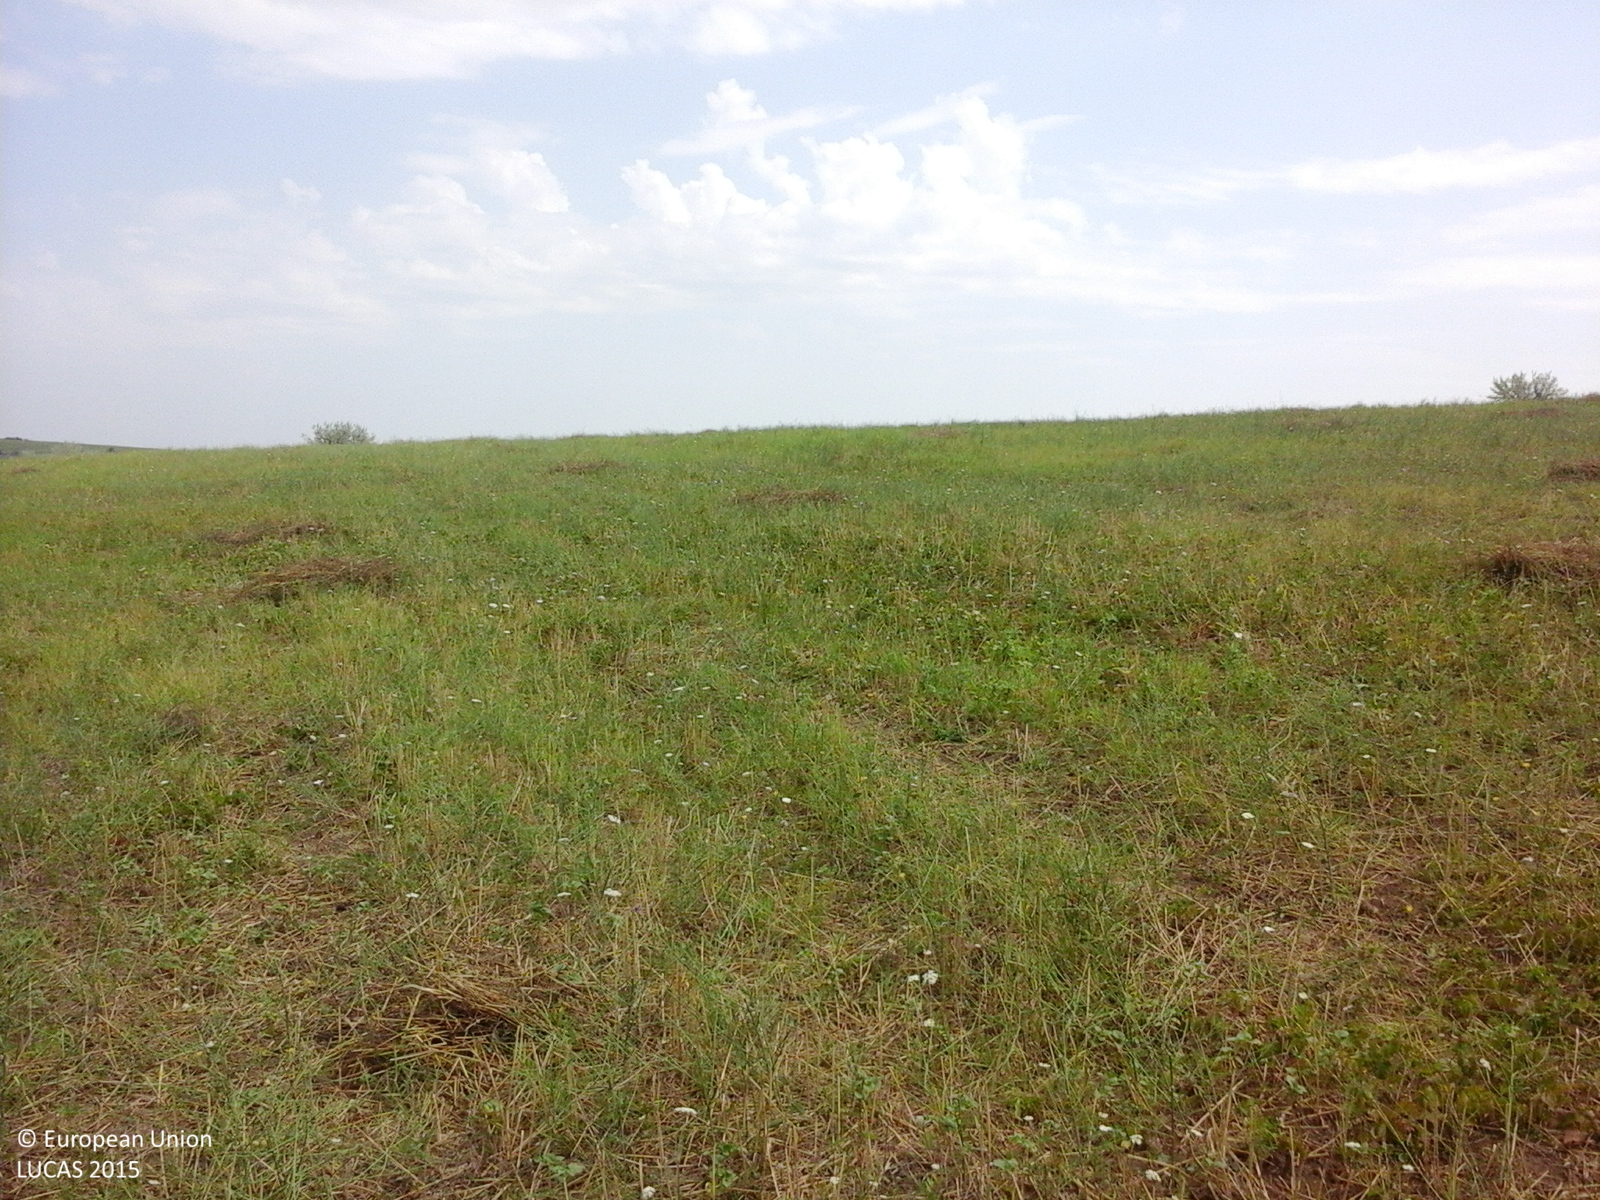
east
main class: Cropland
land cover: Common wheat
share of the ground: 10 - 25 %
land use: Agriculture (excluding fallow land and kitchen gardens)
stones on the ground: < 10 %
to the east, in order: Common wheat; Grassland without tree/shrub cover; Sunflower; Ditches and canals; Abandoned hedges; Spontaneously vegetated surfaces; Grassland with sparse tree/shrub cover
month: August
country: RO
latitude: 44.1623
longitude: 27.8953
